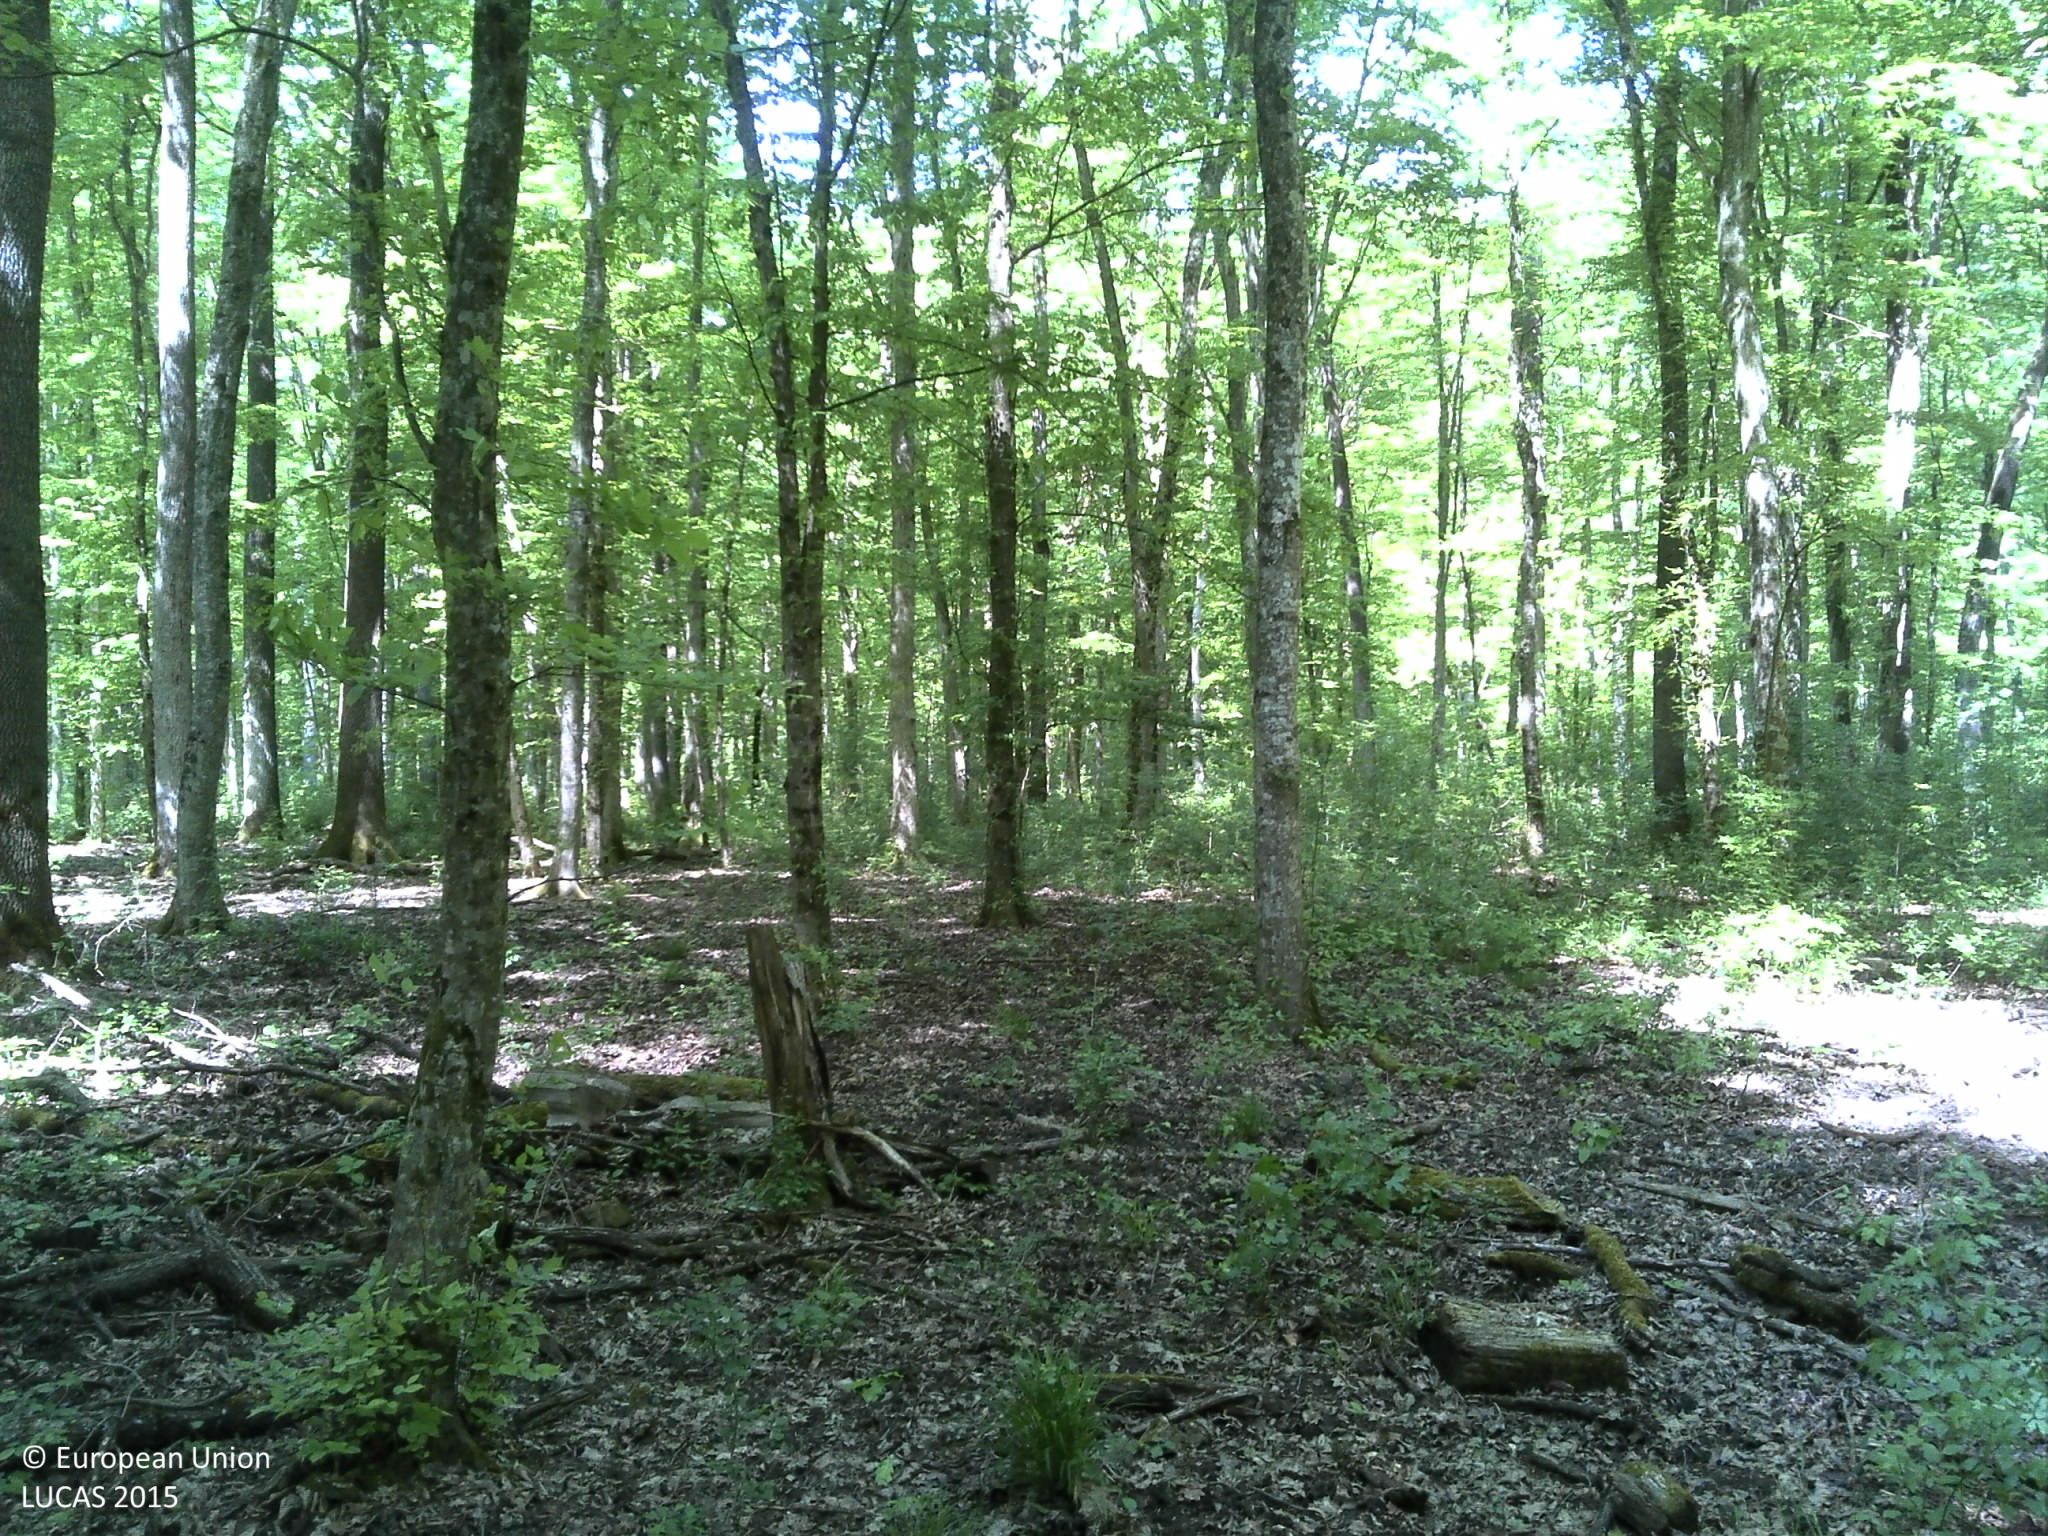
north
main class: Woodland
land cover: Broadleaved woodland
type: mesophytic deciduous forest
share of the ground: > 75 %
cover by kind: broadleaved forest trees 100 %
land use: Forestry
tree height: > 5 m
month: April
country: HR
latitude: 45.0504
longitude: 18.9585
